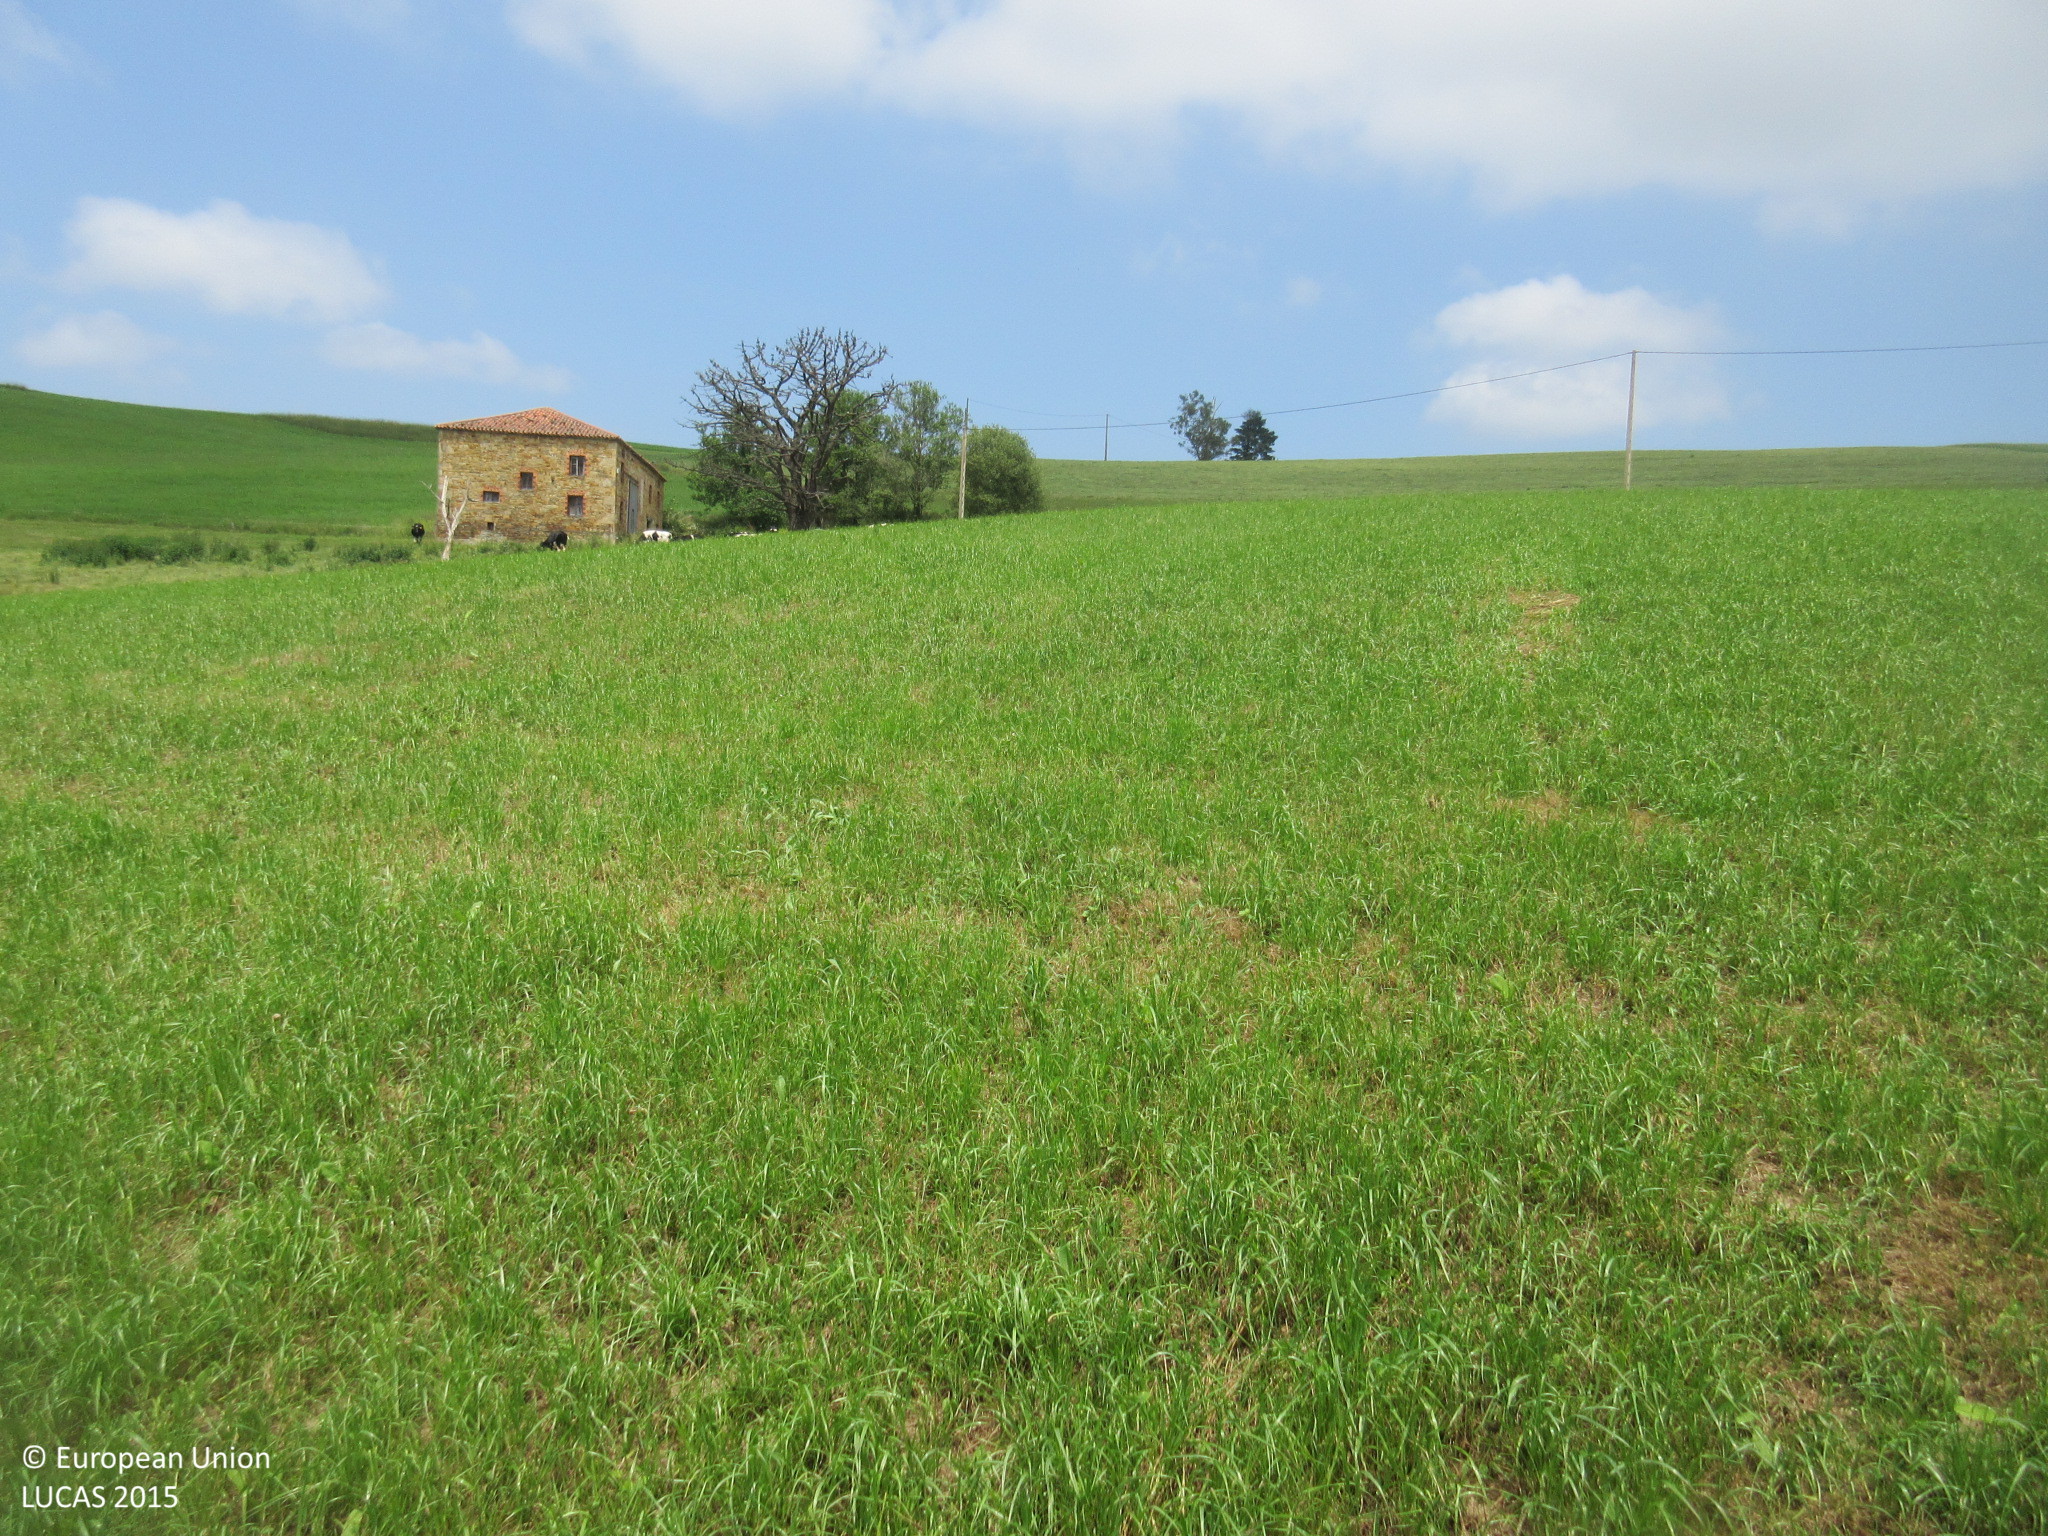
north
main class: Cropland
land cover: Temporary grasslands
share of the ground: > 75 %
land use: Agriculture (excluding fallow land and kitchen gardens)
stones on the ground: < 10 %
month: June
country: ES
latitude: 43.3728
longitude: -3.6336
